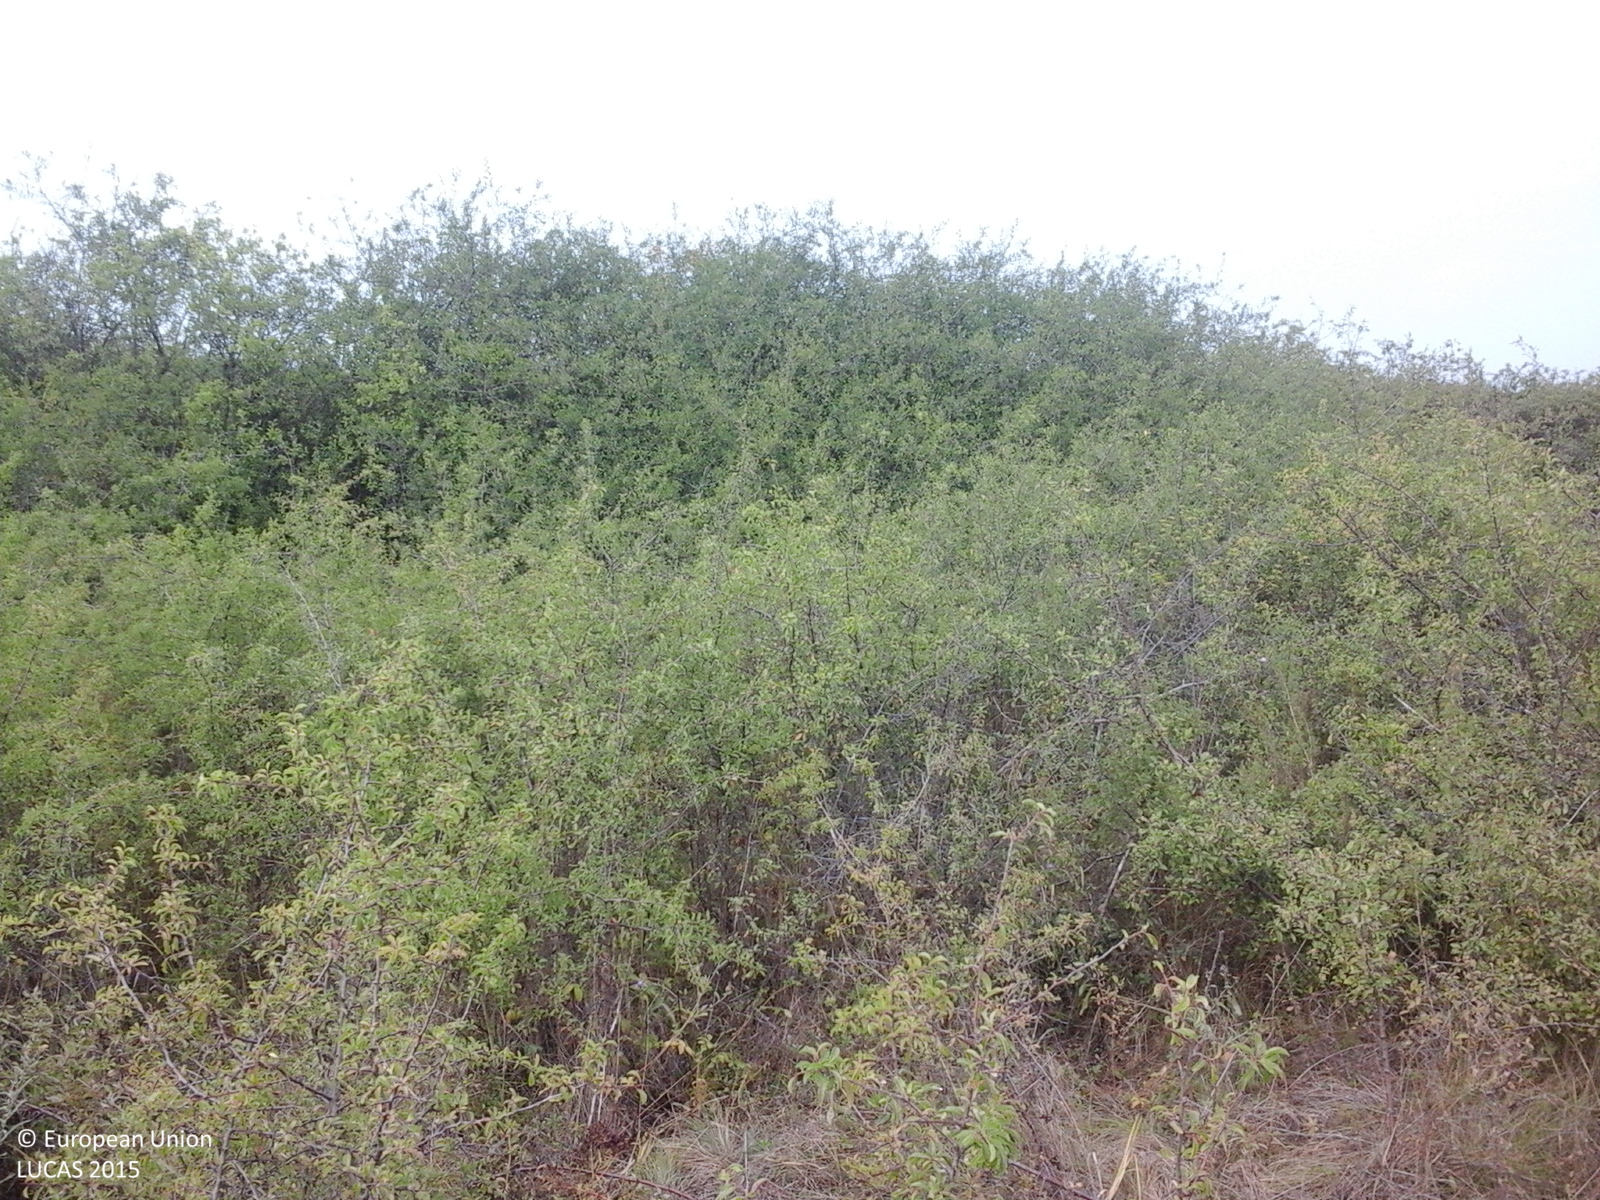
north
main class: Grassland
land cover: Grassland with sparse tree/shrub cover
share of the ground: > 75 %
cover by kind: herbaceous plants 85 %, shrubs 10 %, broadleaved forest trees 5 %
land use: Agriculture (excluding fallow land and kitchen gardens)
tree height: < 5 m
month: August
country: RO
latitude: 46.5215
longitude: 21.7336
